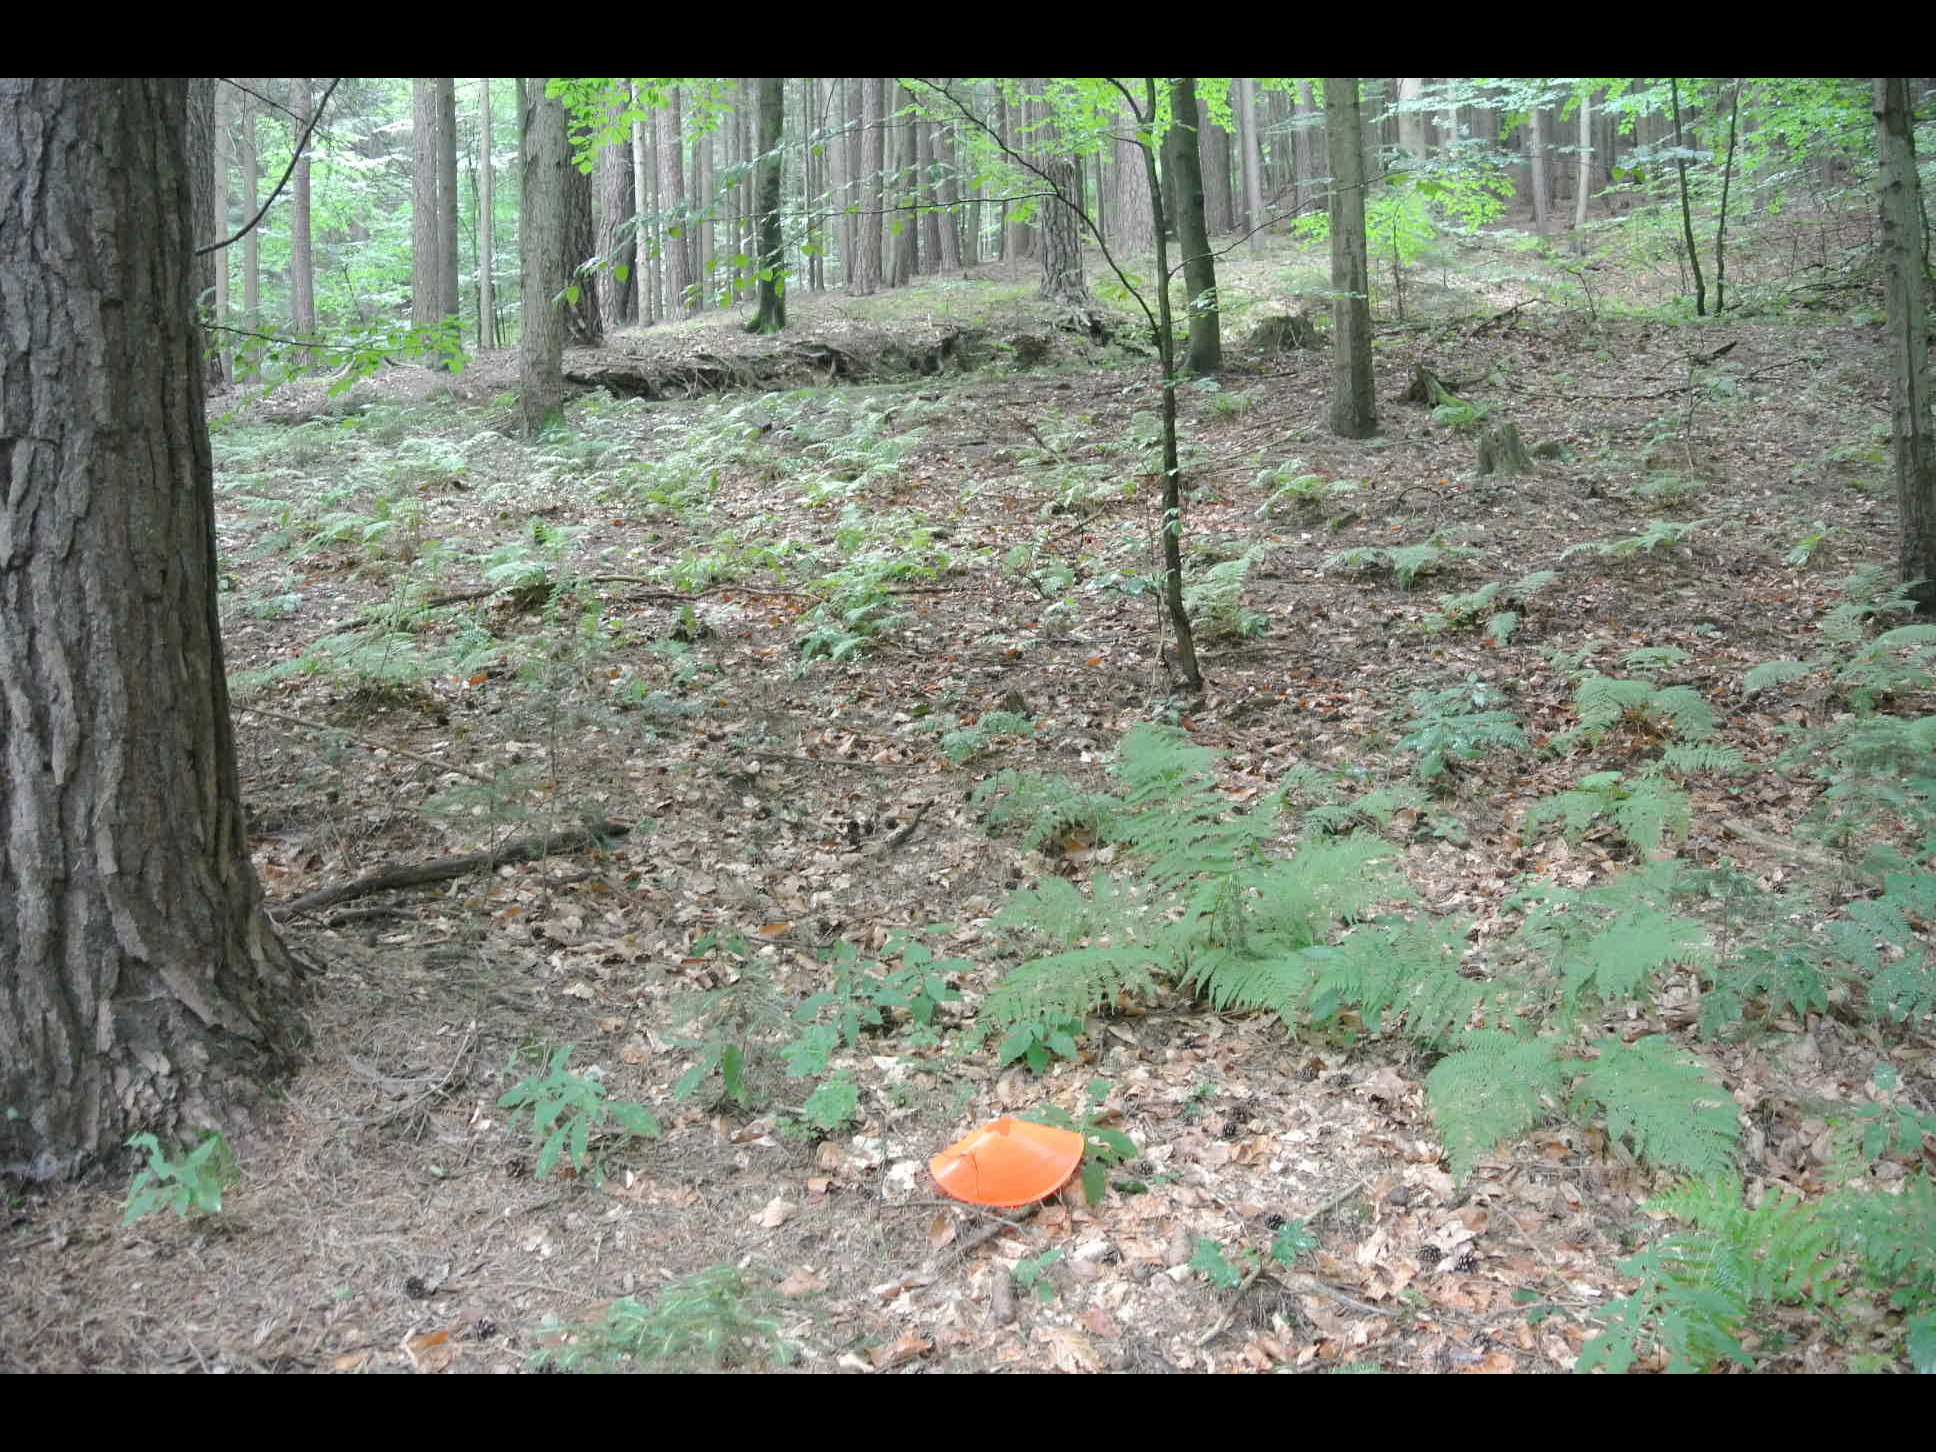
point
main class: Woodland
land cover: Spruce dominated coniferous woodland
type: alpine coniferous forest
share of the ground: > 75 %
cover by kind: coniferous forest trees 75 %, broadleaved forest trees 20 %, herbaceous plants 5 %
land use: Forestry
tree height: > 5 m
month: July
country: AT
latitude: 47.6209
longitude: 16.1101
